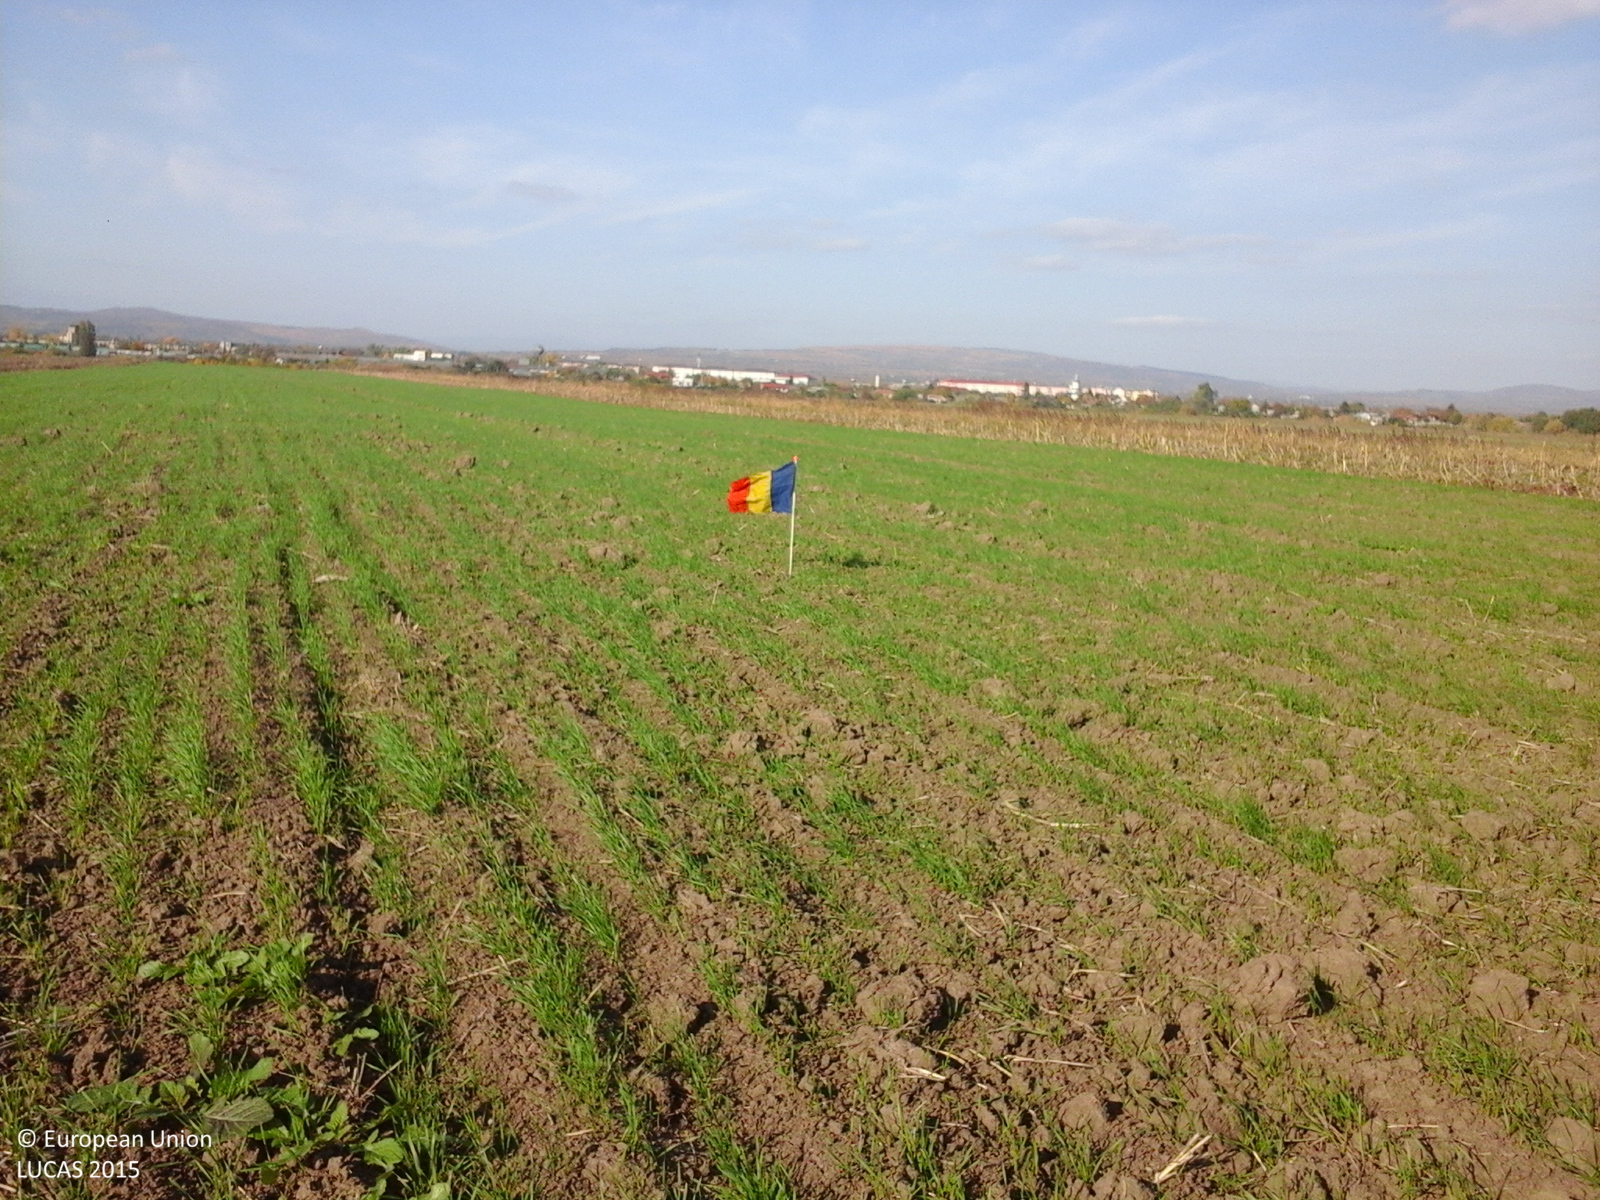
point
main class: Cropland
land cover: Common wheat
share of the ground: 10 - 25 %
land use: Agriculture (excluding fallow land and kitchen gardens)
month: October
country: RO
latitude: 45.5608
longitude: 27.1445
